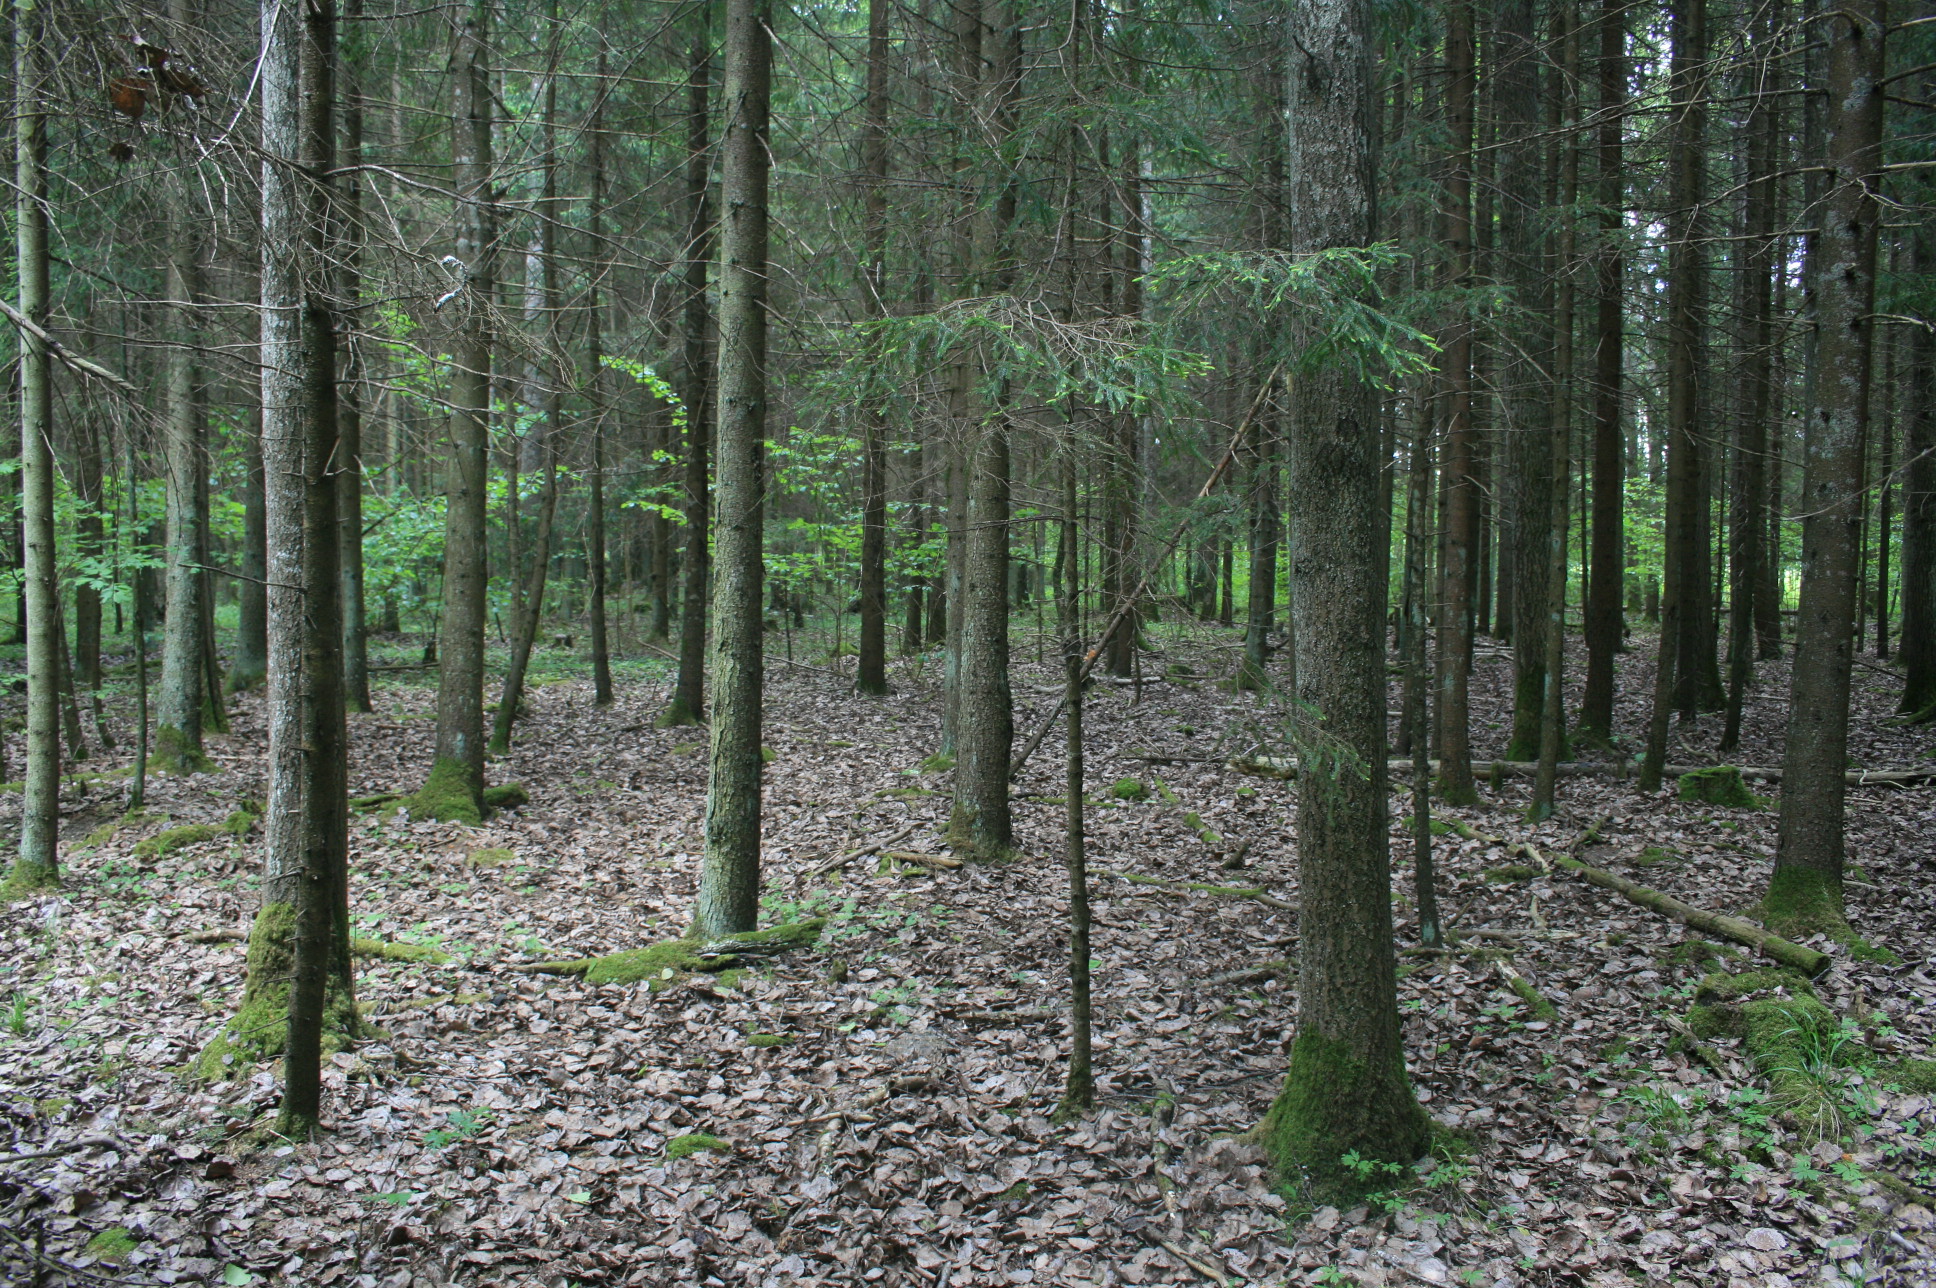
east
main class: Woodland
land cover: Spruce dominated mixed woodland
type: hemiboreal forest and nemoral coniferous forest and mixed broadleaved-coniferous forest
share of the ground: > 75 %
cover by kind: coniferous forest trees 65 %, broadleaved forest trees 30 %, lichens and mosses 5 %
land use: Forestry
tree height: > 5 m
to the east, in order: Spruce dominated mixed woodland; Broadleaved woodland; Ditches and canals; Broadleaved woodland
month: June
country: LT
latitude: 56.2246
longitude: 22.3622
